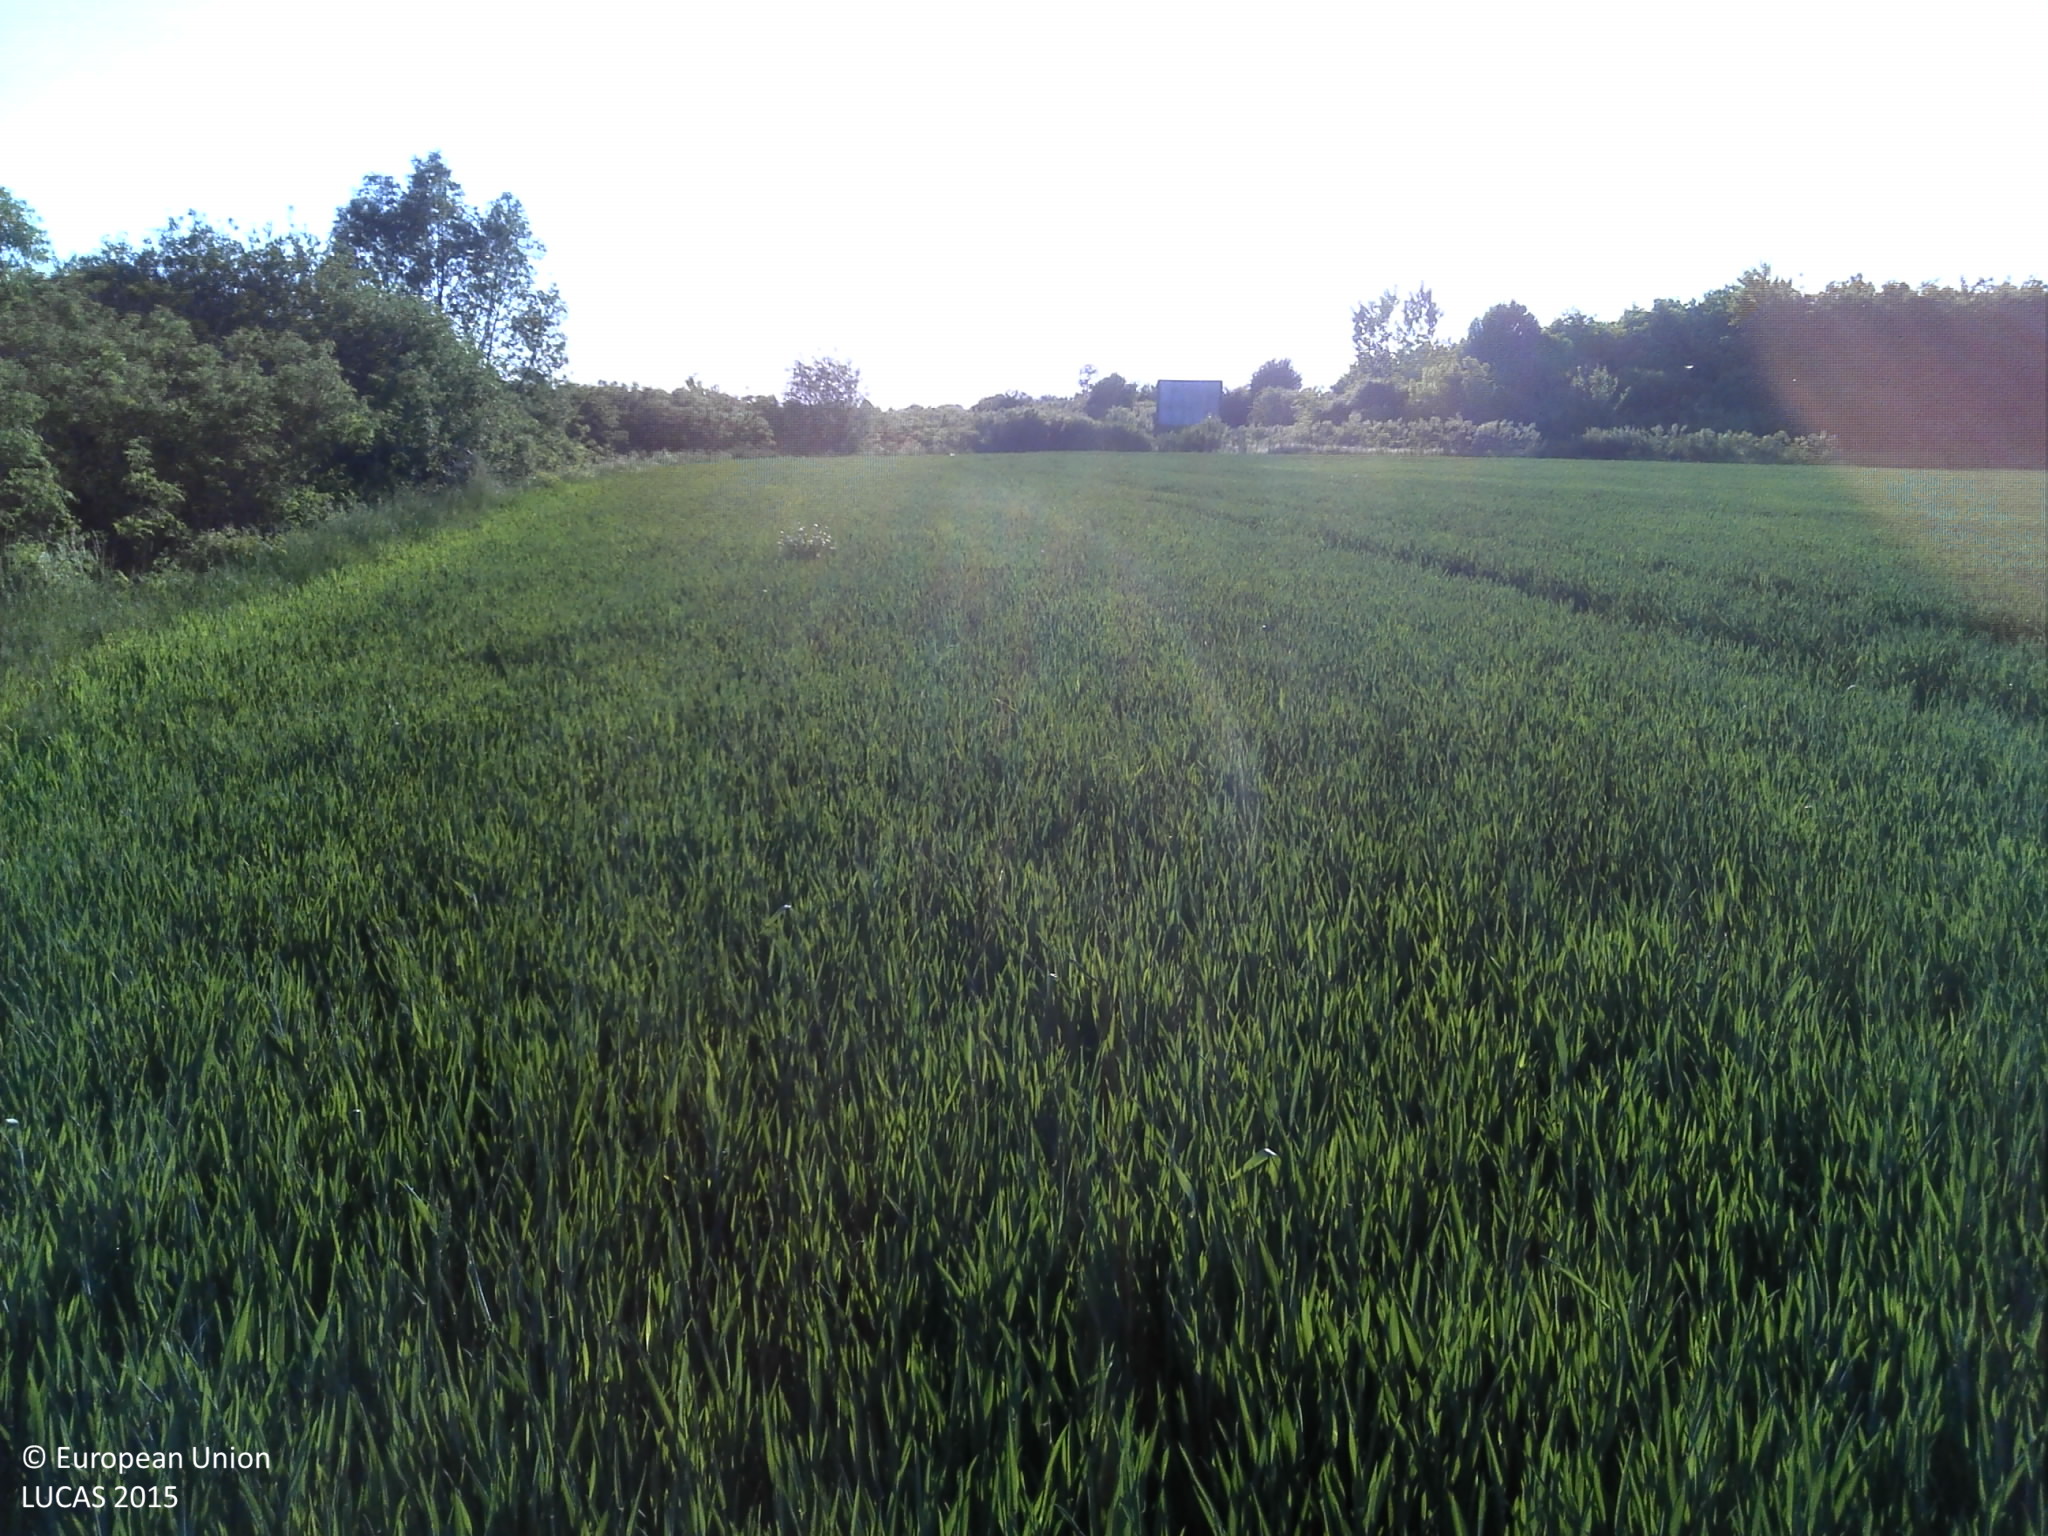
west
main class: Cropland
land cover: Common wheat
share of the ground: > 75 %
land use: Agriculture (excluding fallow land and kitchen gardens)
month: May
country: HR
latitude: 45.1821
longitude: 18.2375
